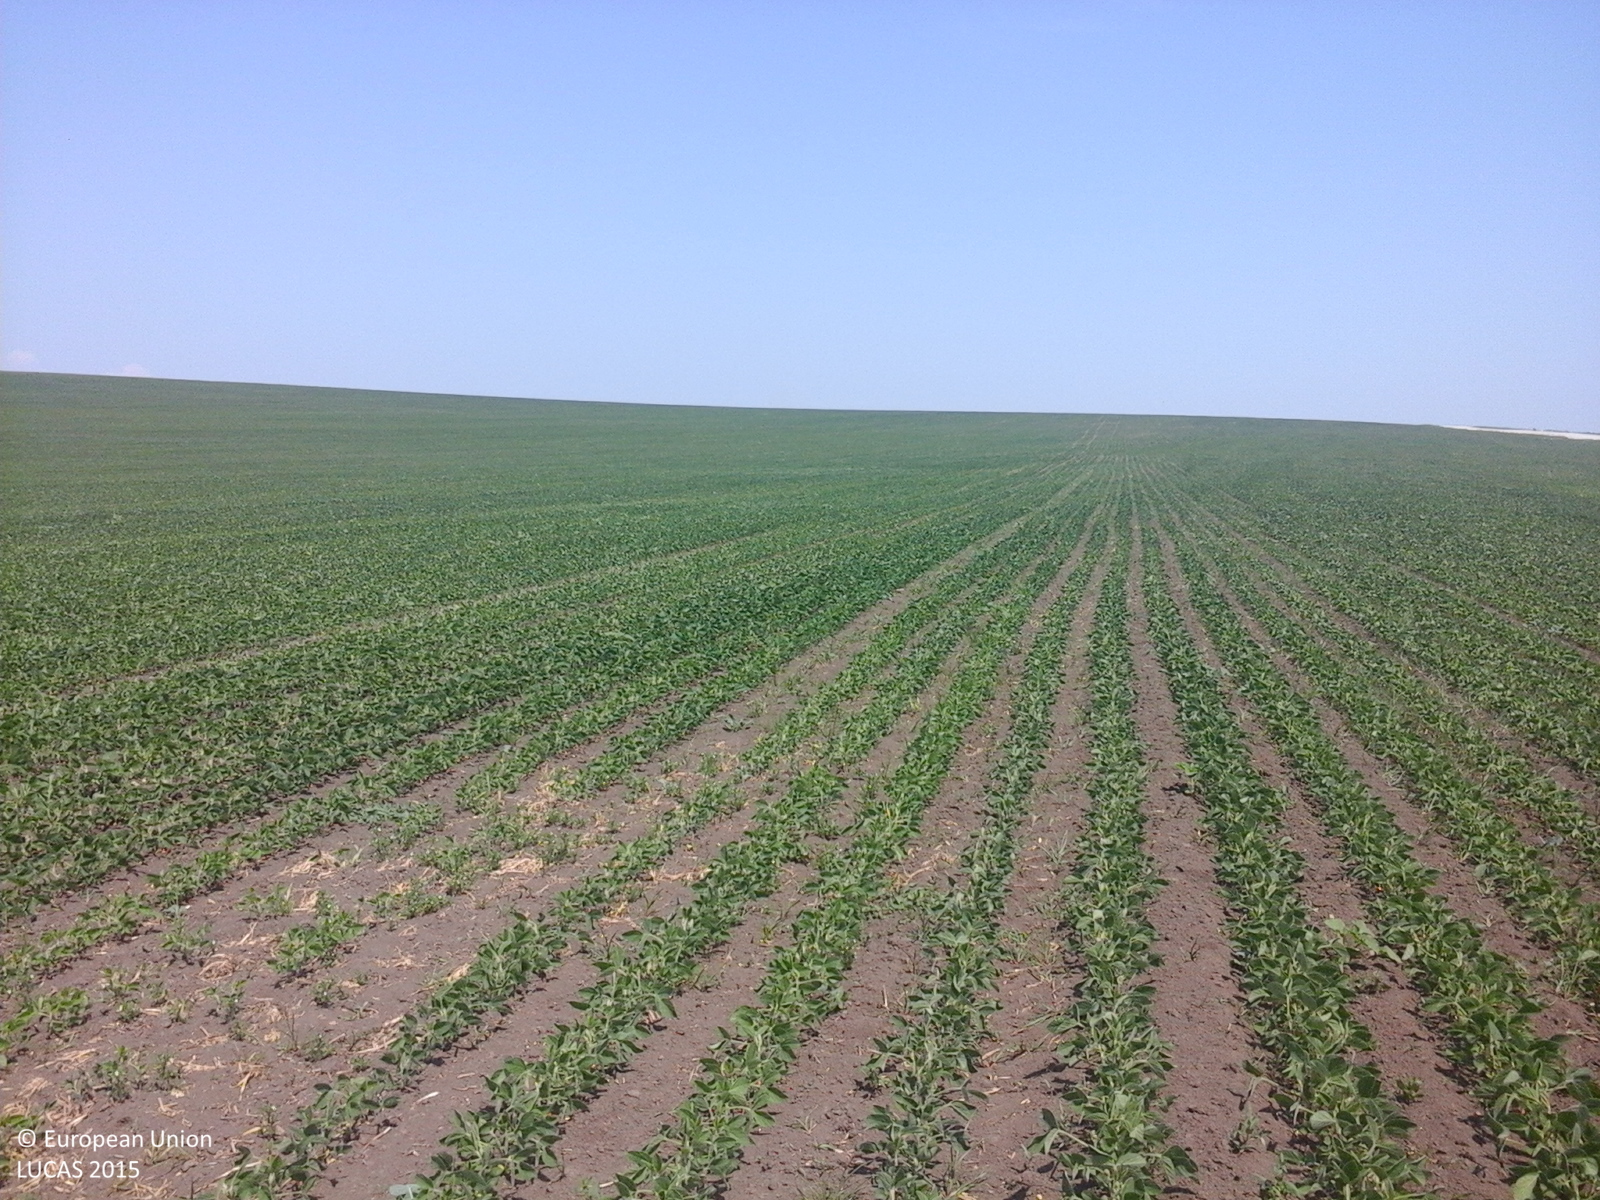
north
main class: Cropland
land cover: Soya
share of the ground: 50 - 75 %
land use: Agriculture (excluding fallow land and kitchen gardens)
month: June
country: RO
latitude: 46.8570
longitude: 26.6276
